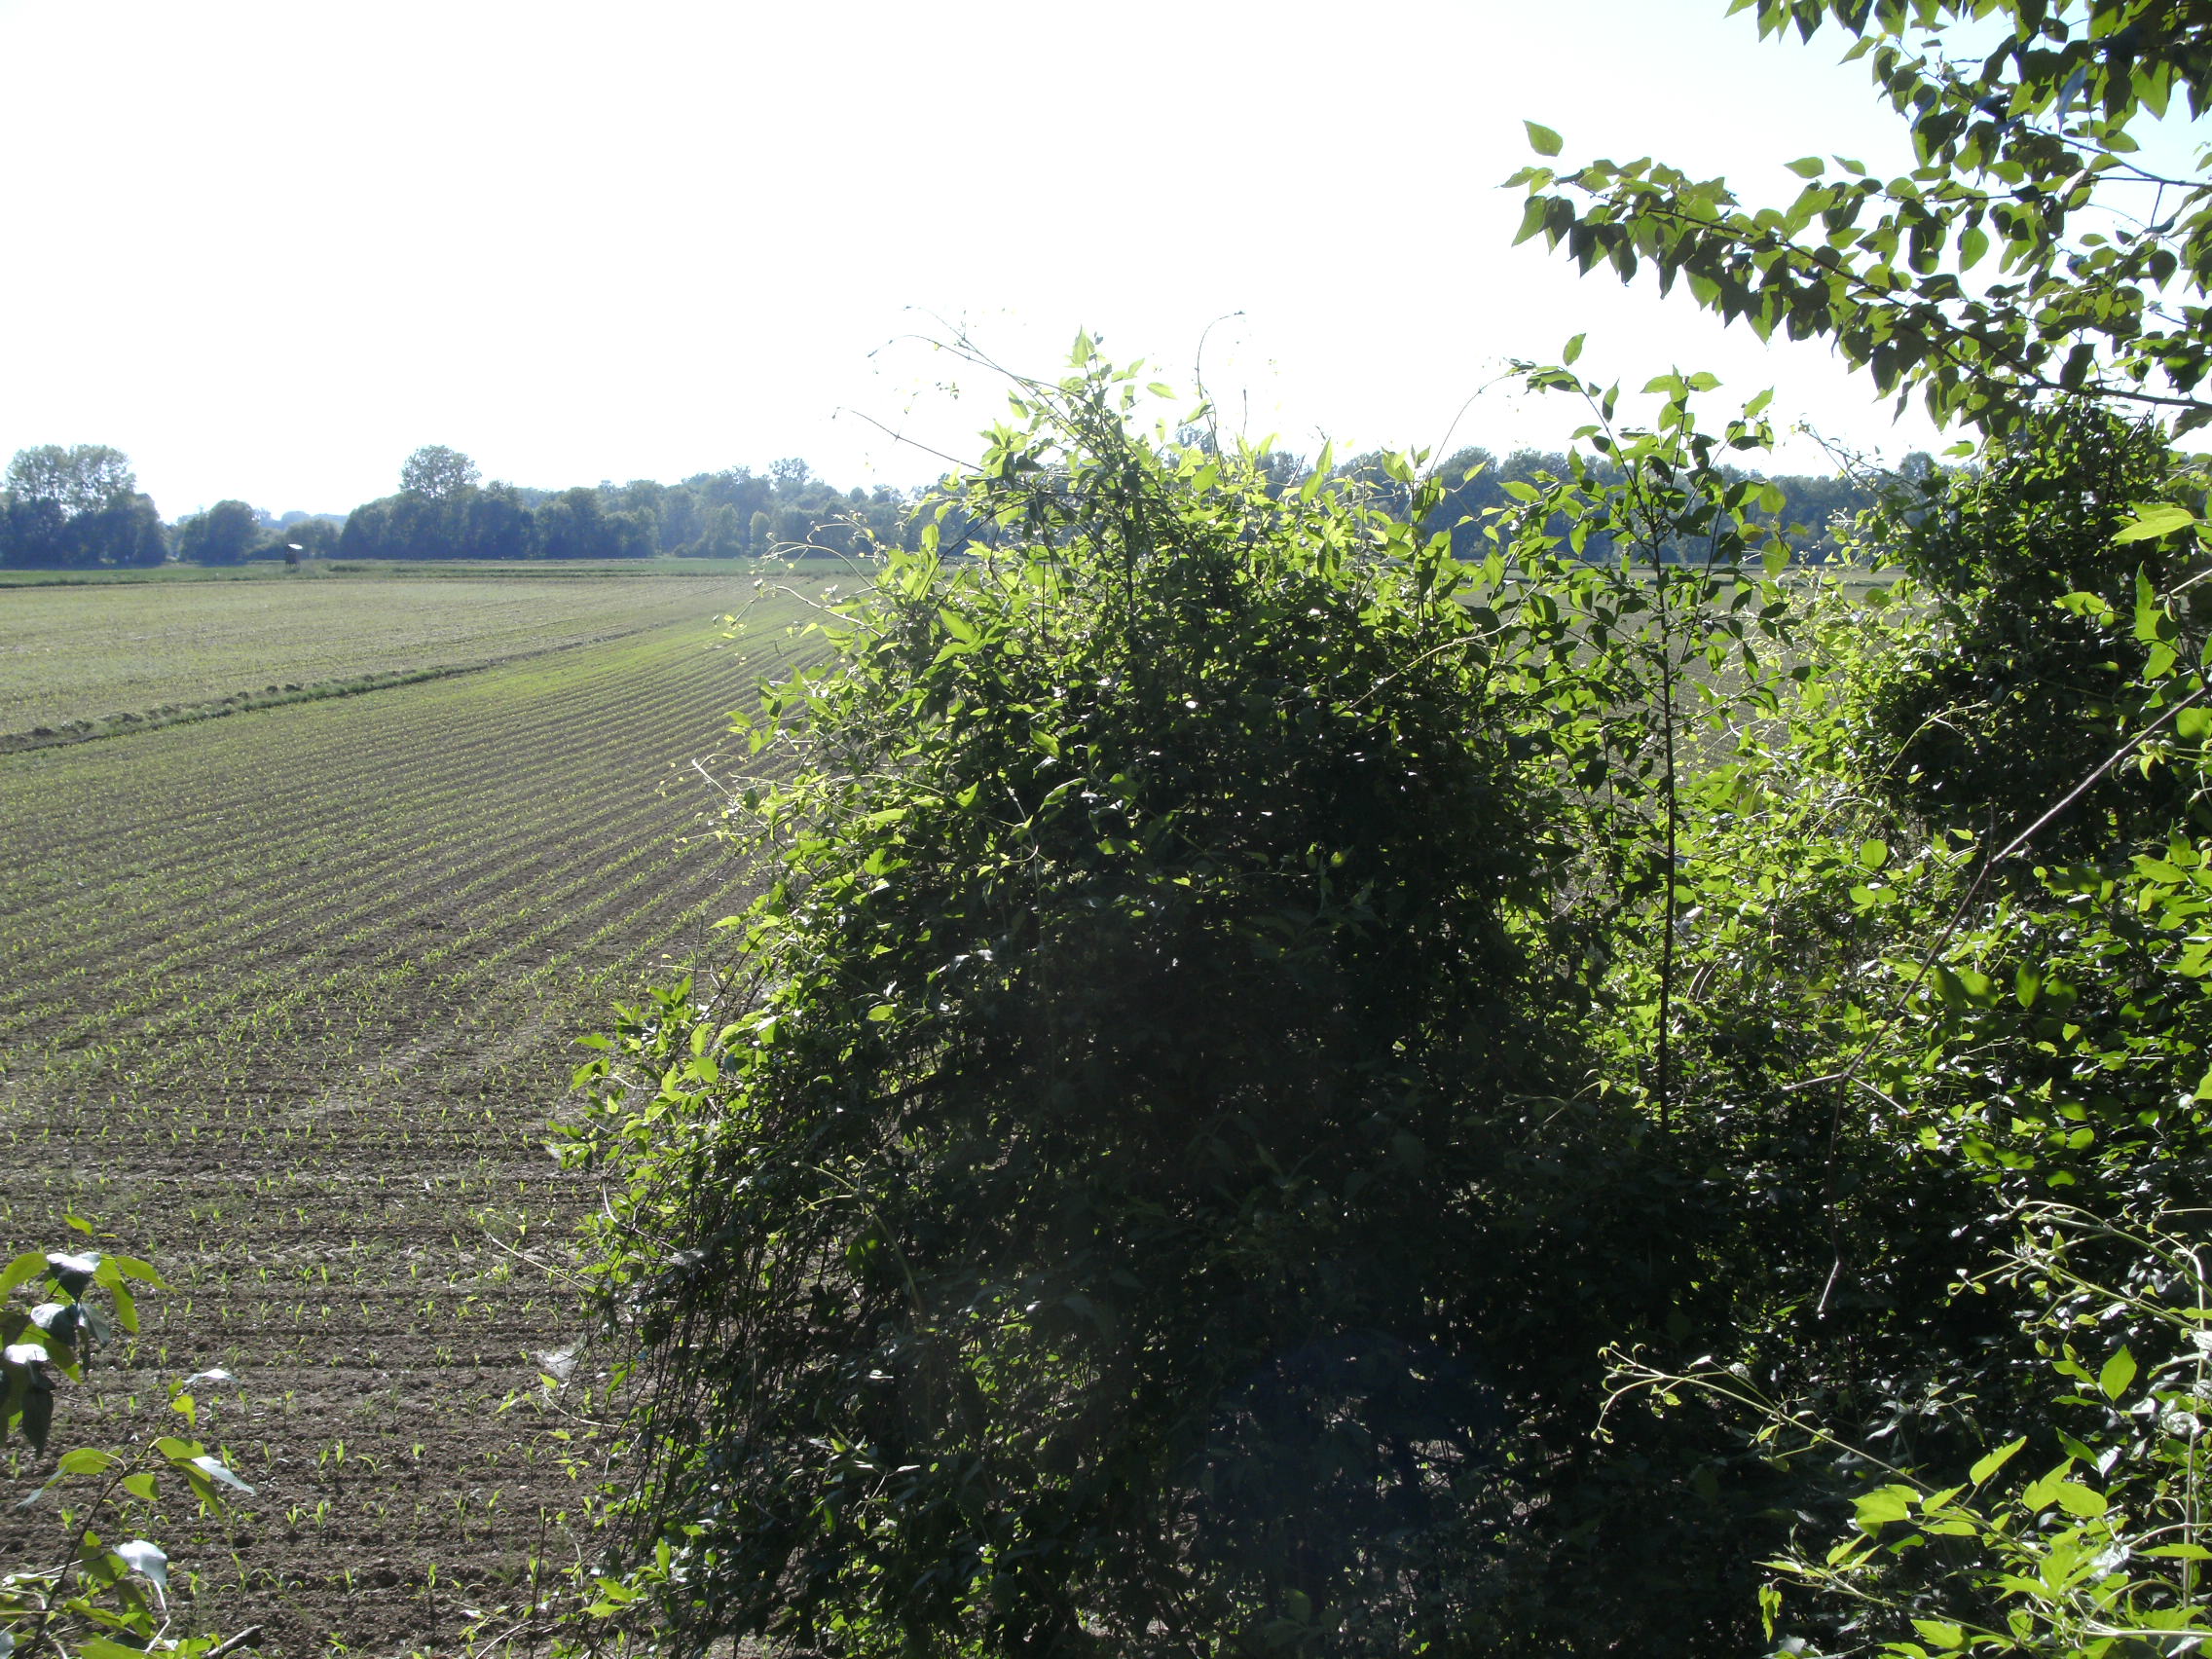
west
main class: Woodland
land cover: Broadleaved woodland
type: mesophytic deciduous forest
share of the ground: > 75 %
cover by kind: broadleaved forest trees 80 %, herbaceous plants 20 %
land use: Semi-natural and natural areas not in use
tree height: > 5 m
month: May
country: AT
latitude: 48.3070
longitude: 14.1661
